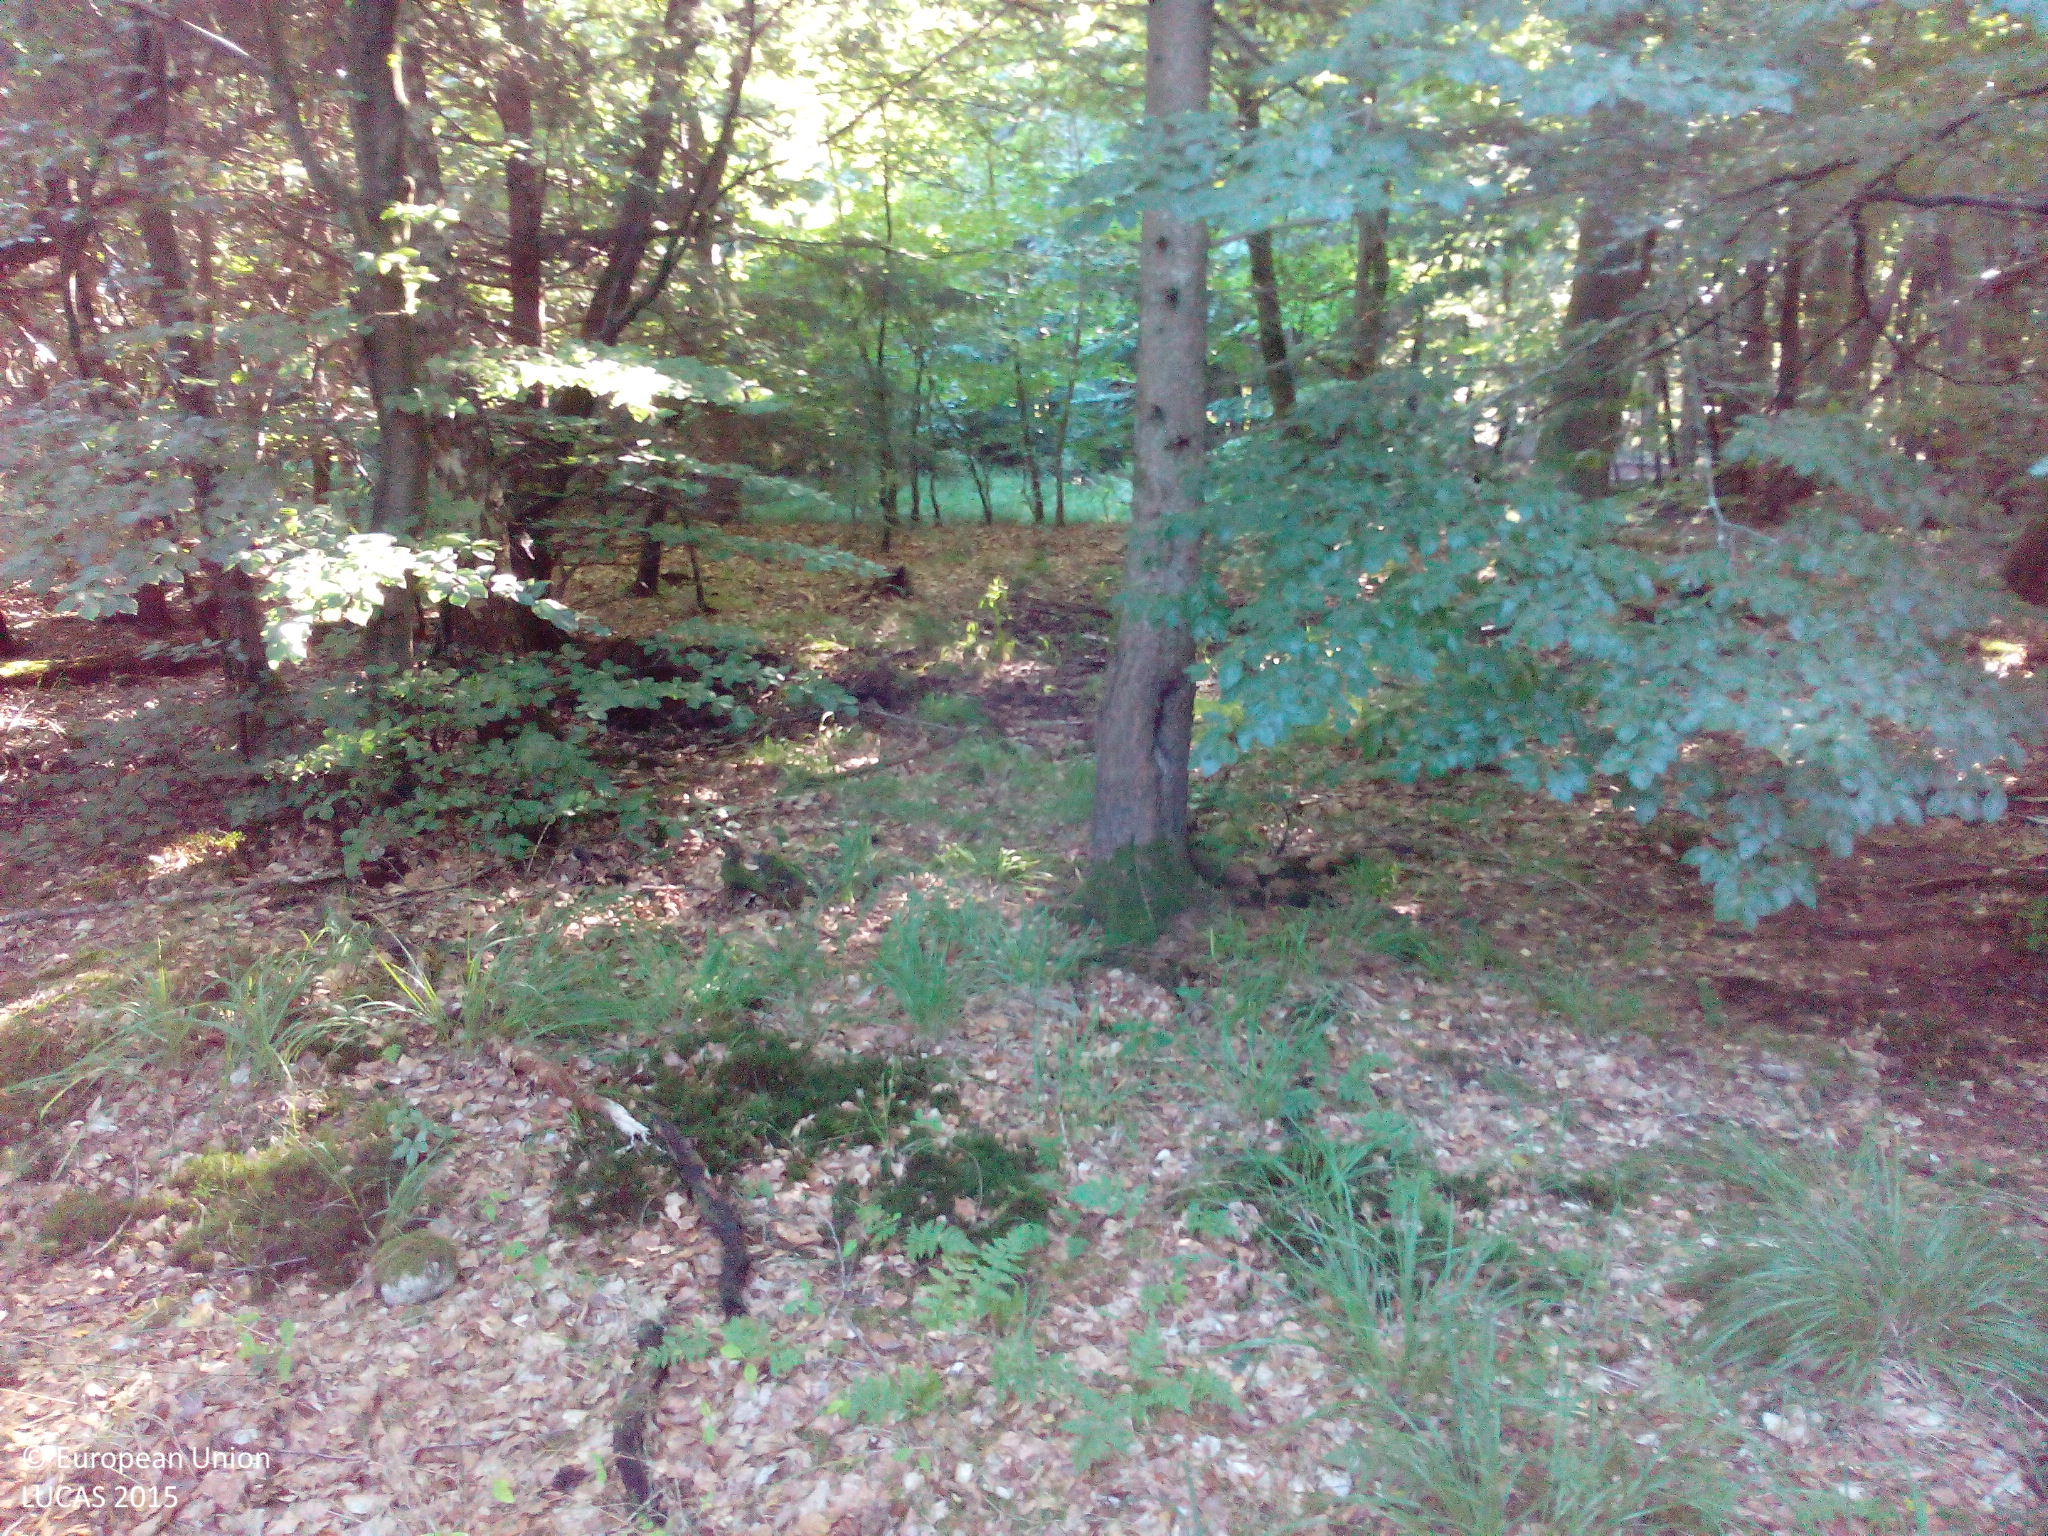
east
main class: Woodland
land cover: Broadleaved woodland
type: beech forest
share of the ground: > 75 %
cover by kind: broadleaved forest trees 85 %, herbaceous plants 10 %, shrubs 5 %
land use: Forestry
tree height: > 5 m
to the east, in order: Broadleaved woodland; Ditches and canals; Spruce dominated coniferous woodland; Spruce dominated mixed woodland; Broadleaved woodland; Tracks; Broadleaved woodland; Tracks; Broadleaved woodland
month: September
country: DE
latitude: 54.2064
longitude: 12.3447
